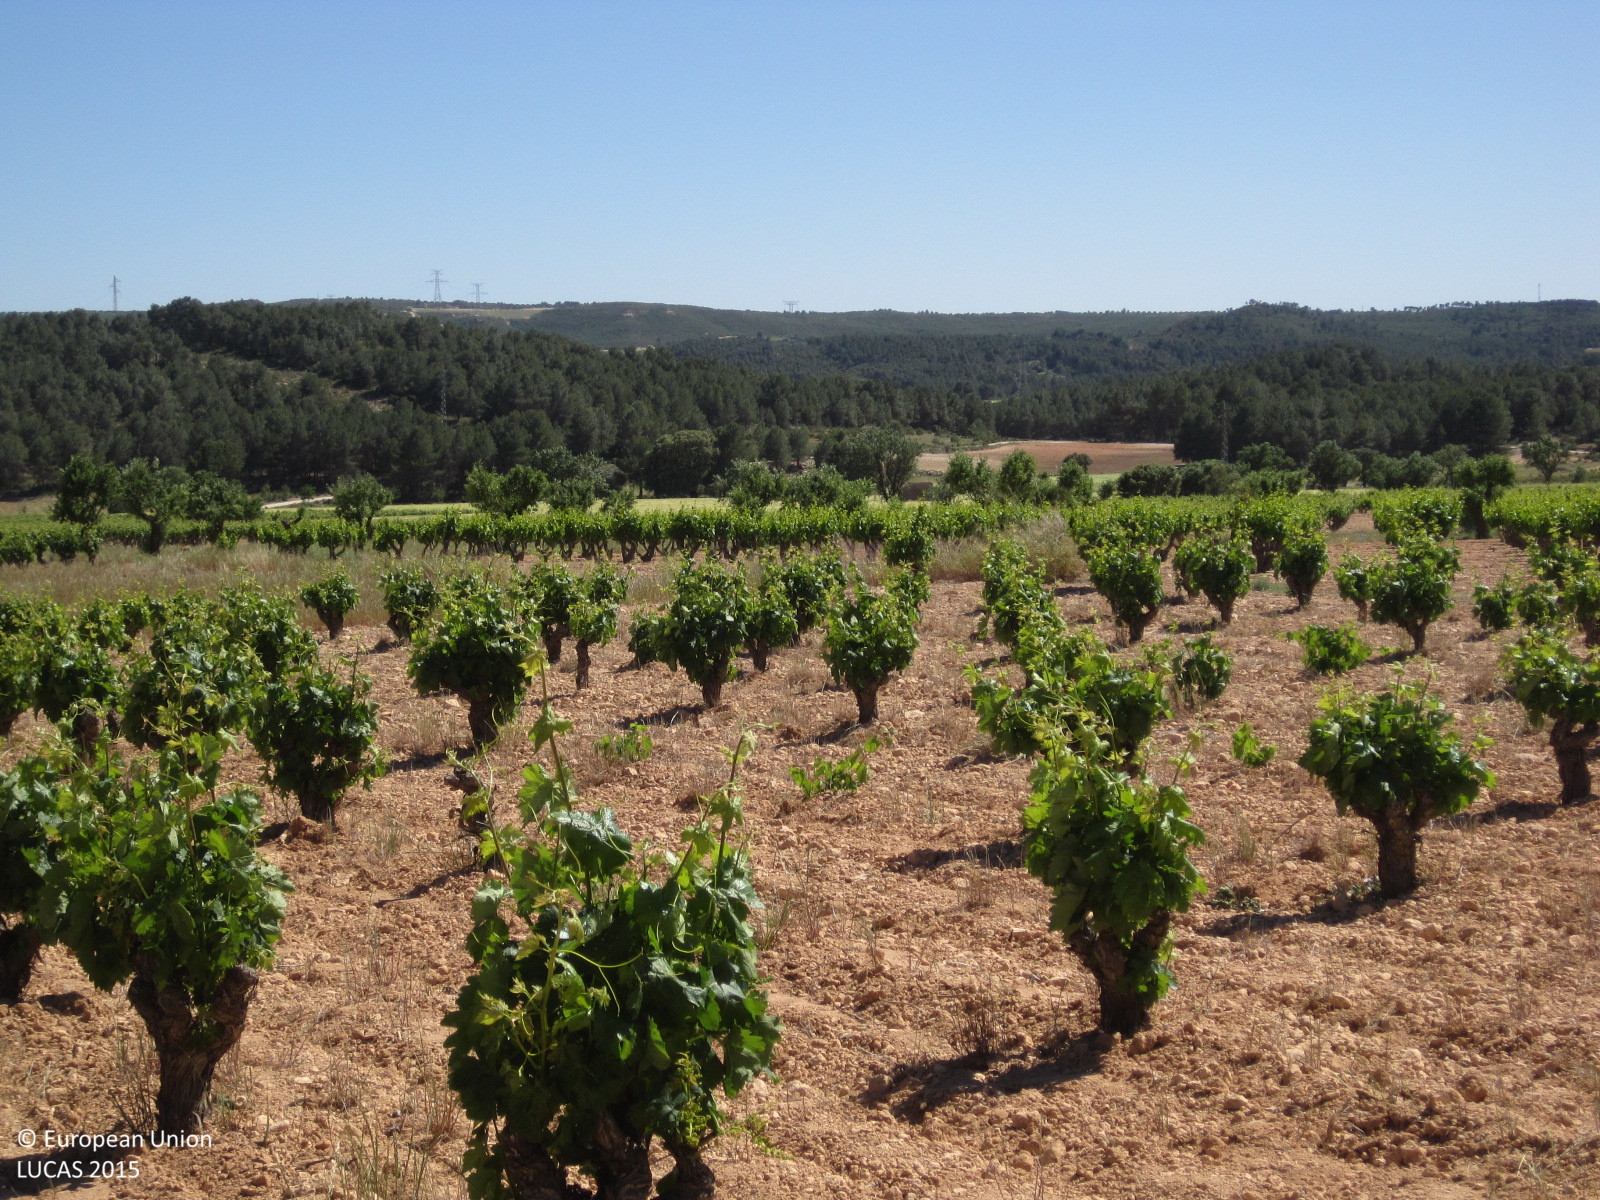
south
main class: Cropland
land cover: Vineyards
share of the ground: 10 - 25 %
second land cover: Spontaneously vegetated surfaces
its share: < 10 %
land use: Agriculture (excluding fallow land and kitchen gardens)
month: May
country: ES
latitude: 39.4172
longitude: -1.0929
